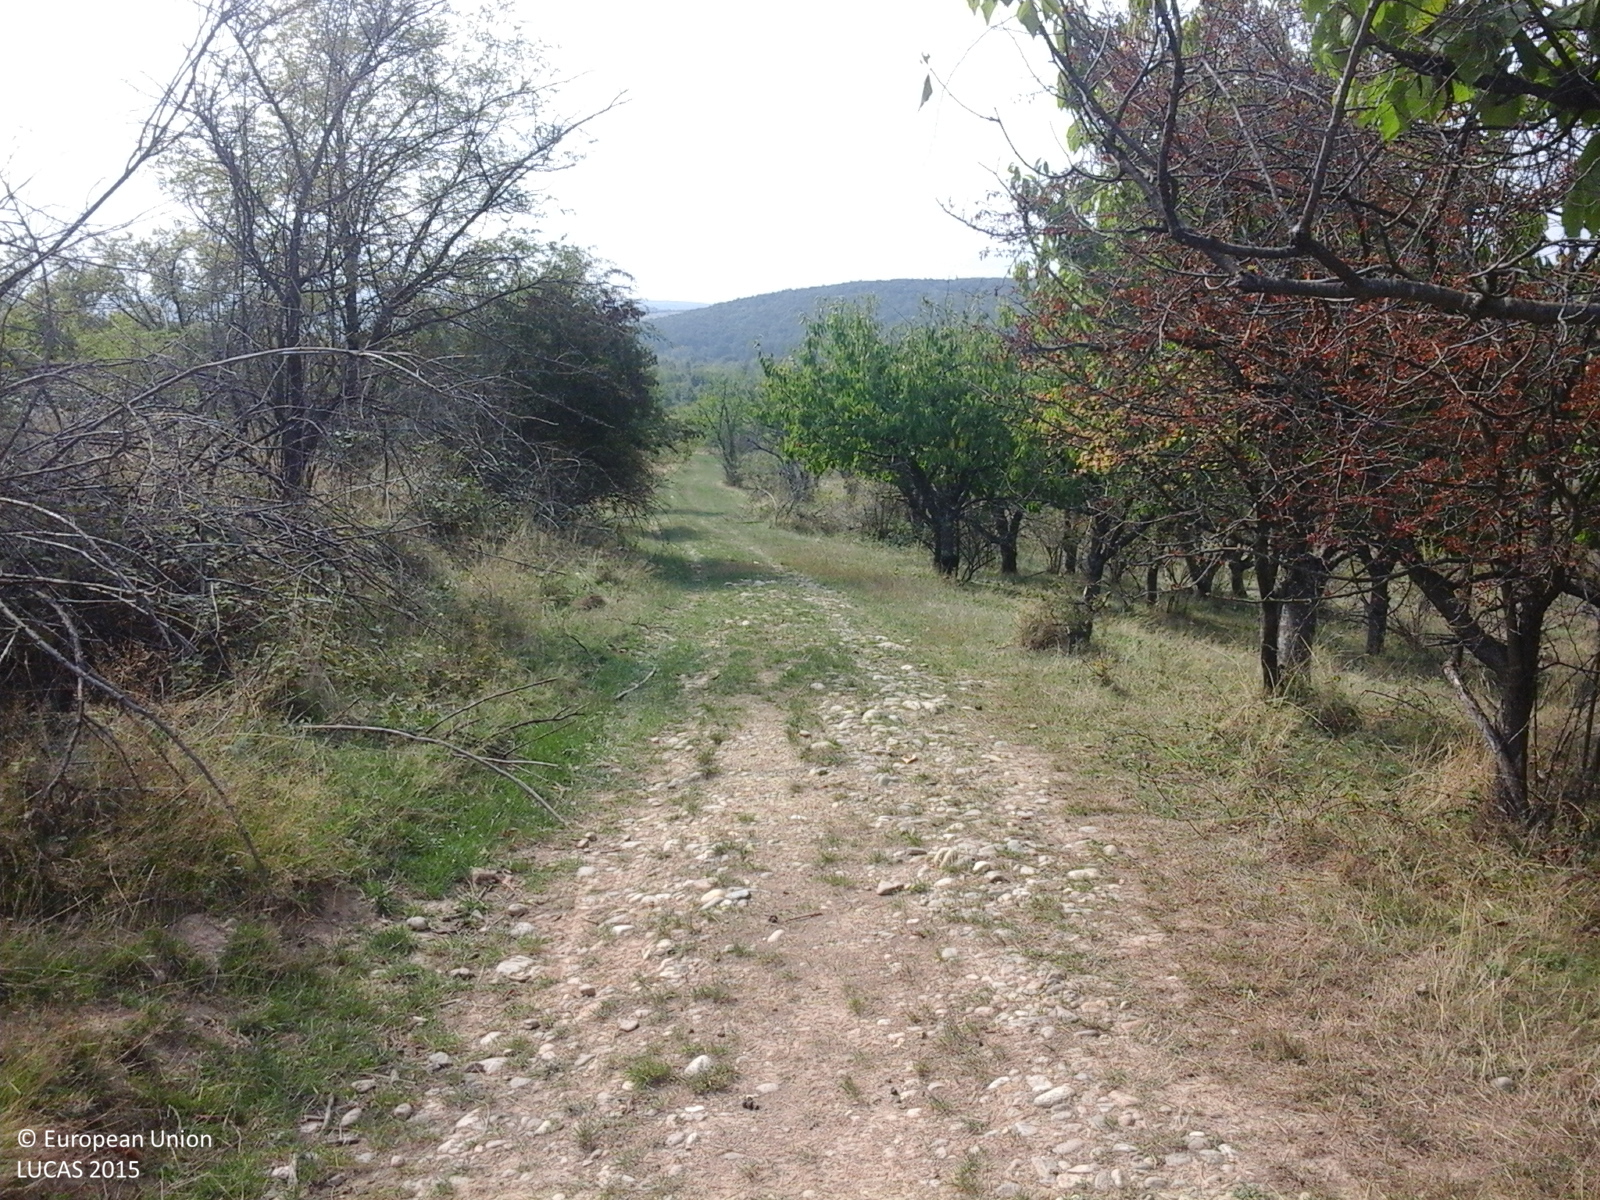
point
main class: Cropland
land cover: Cherry fruit
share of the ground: 25 - 50 %
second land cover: Grassland without tree/shrub cover
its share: > 75 %
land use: Agriculture (excluding fallow land and kitchen gardens)
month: September
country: RO
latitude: 45.5145
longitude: 22.1113
